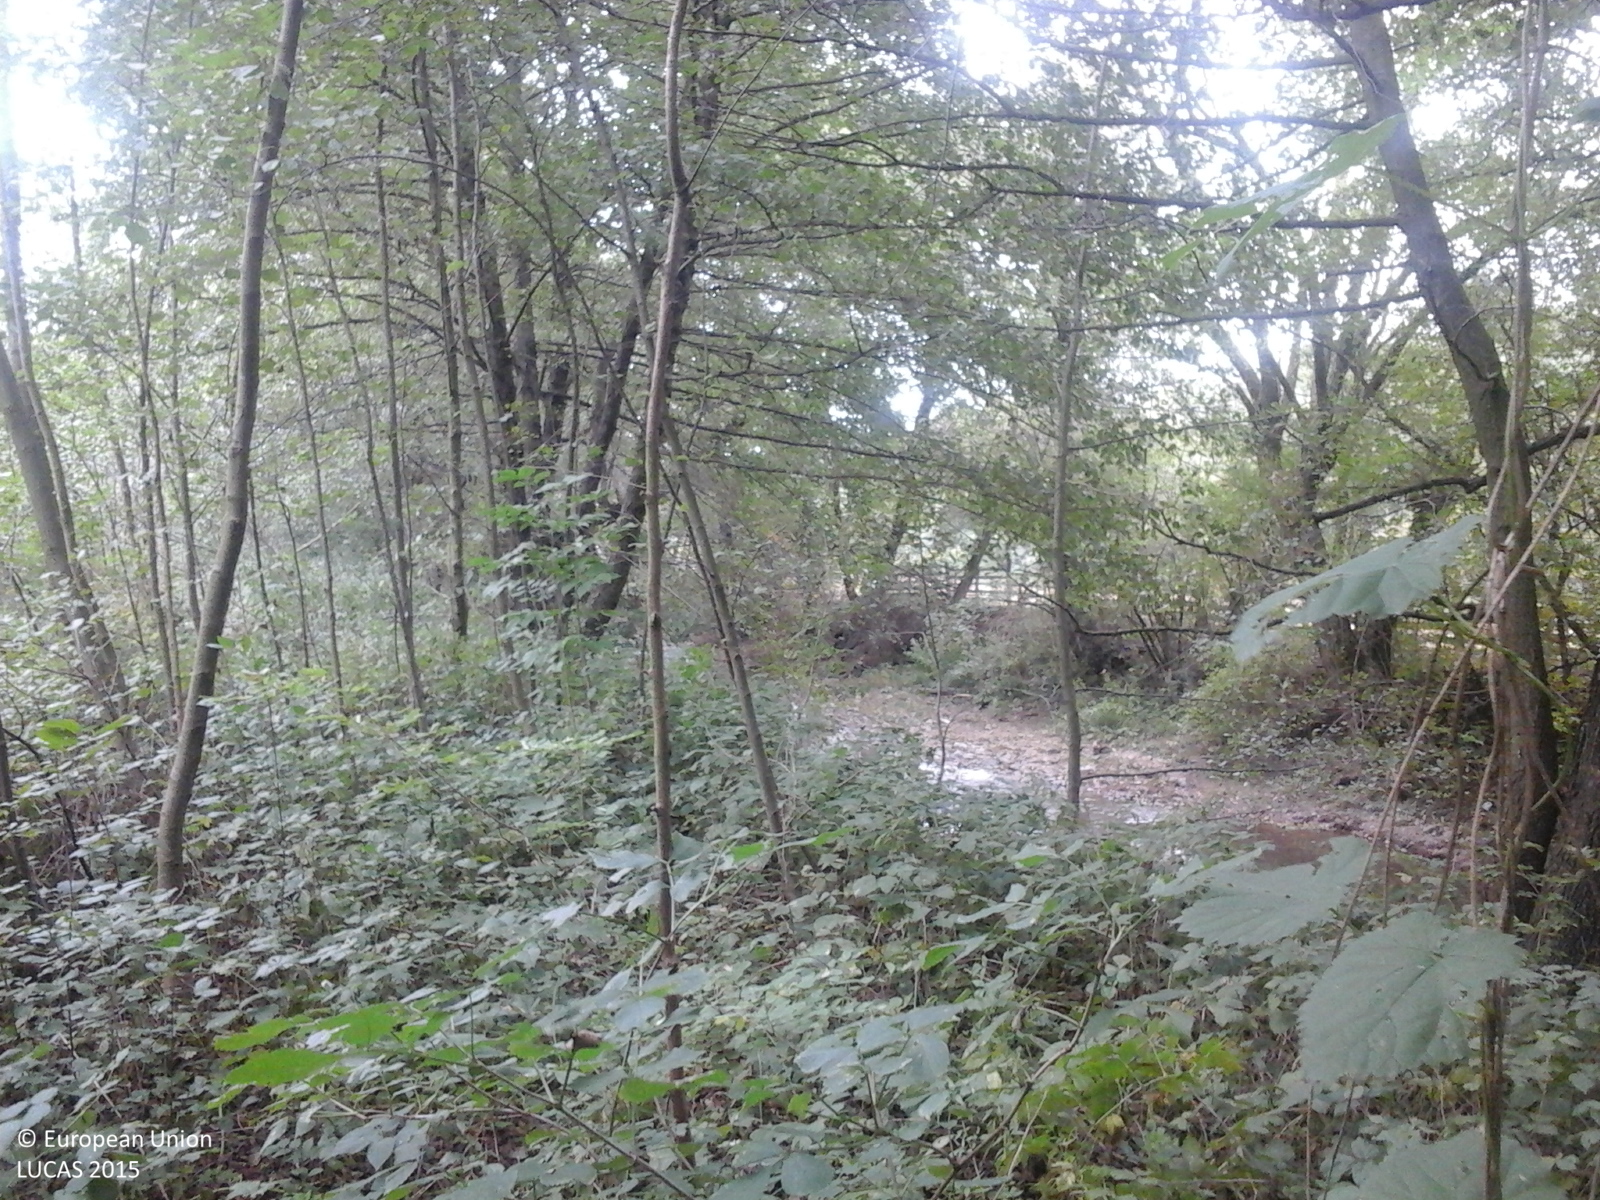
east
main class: Woodland
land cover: Broadleaved woodland
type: floodplain forest
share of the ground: > 75 %
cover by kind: broadleaved forest trees 80 %, herbaceous plants 15 %, shrubs 5 %
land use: Forestry
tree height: > 5 m
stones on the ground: < 10 %
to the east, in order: Broadleaved woodland; Inland fresh running water; Broadleaved woodland; Fences; Grassland without tree/shrub cover; Maize; Fences; Maize
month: October
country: RO
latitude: 46.0910
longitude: 23.3716
